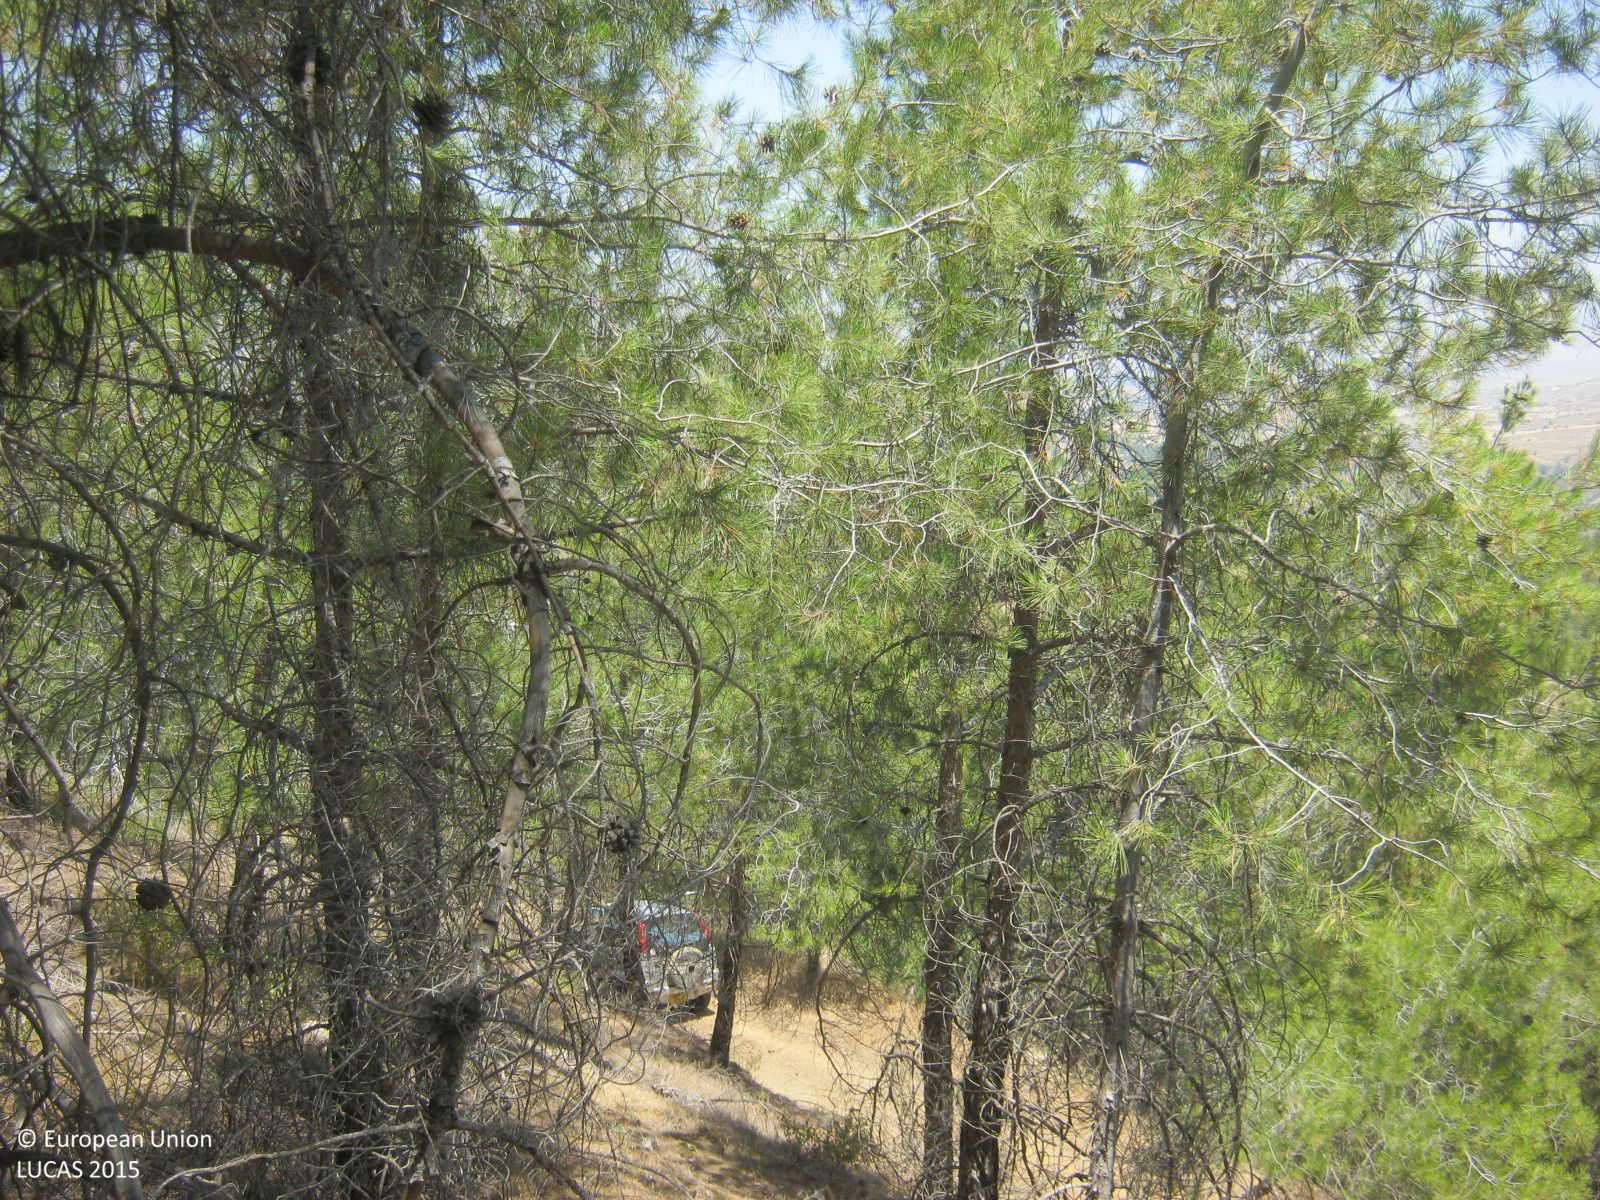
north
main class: Woodland
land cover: Pine dominated coniferous woodland
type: coniferous forest of the mediterranean region
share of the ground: > 75 %
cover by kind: coniferous forest trees 80 %, shrubs 10 %, unconsolidated bare surface 10 %
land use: Forestry
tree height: > 5 m
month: June
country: CY
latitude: 35.0195
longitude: 33.0714
